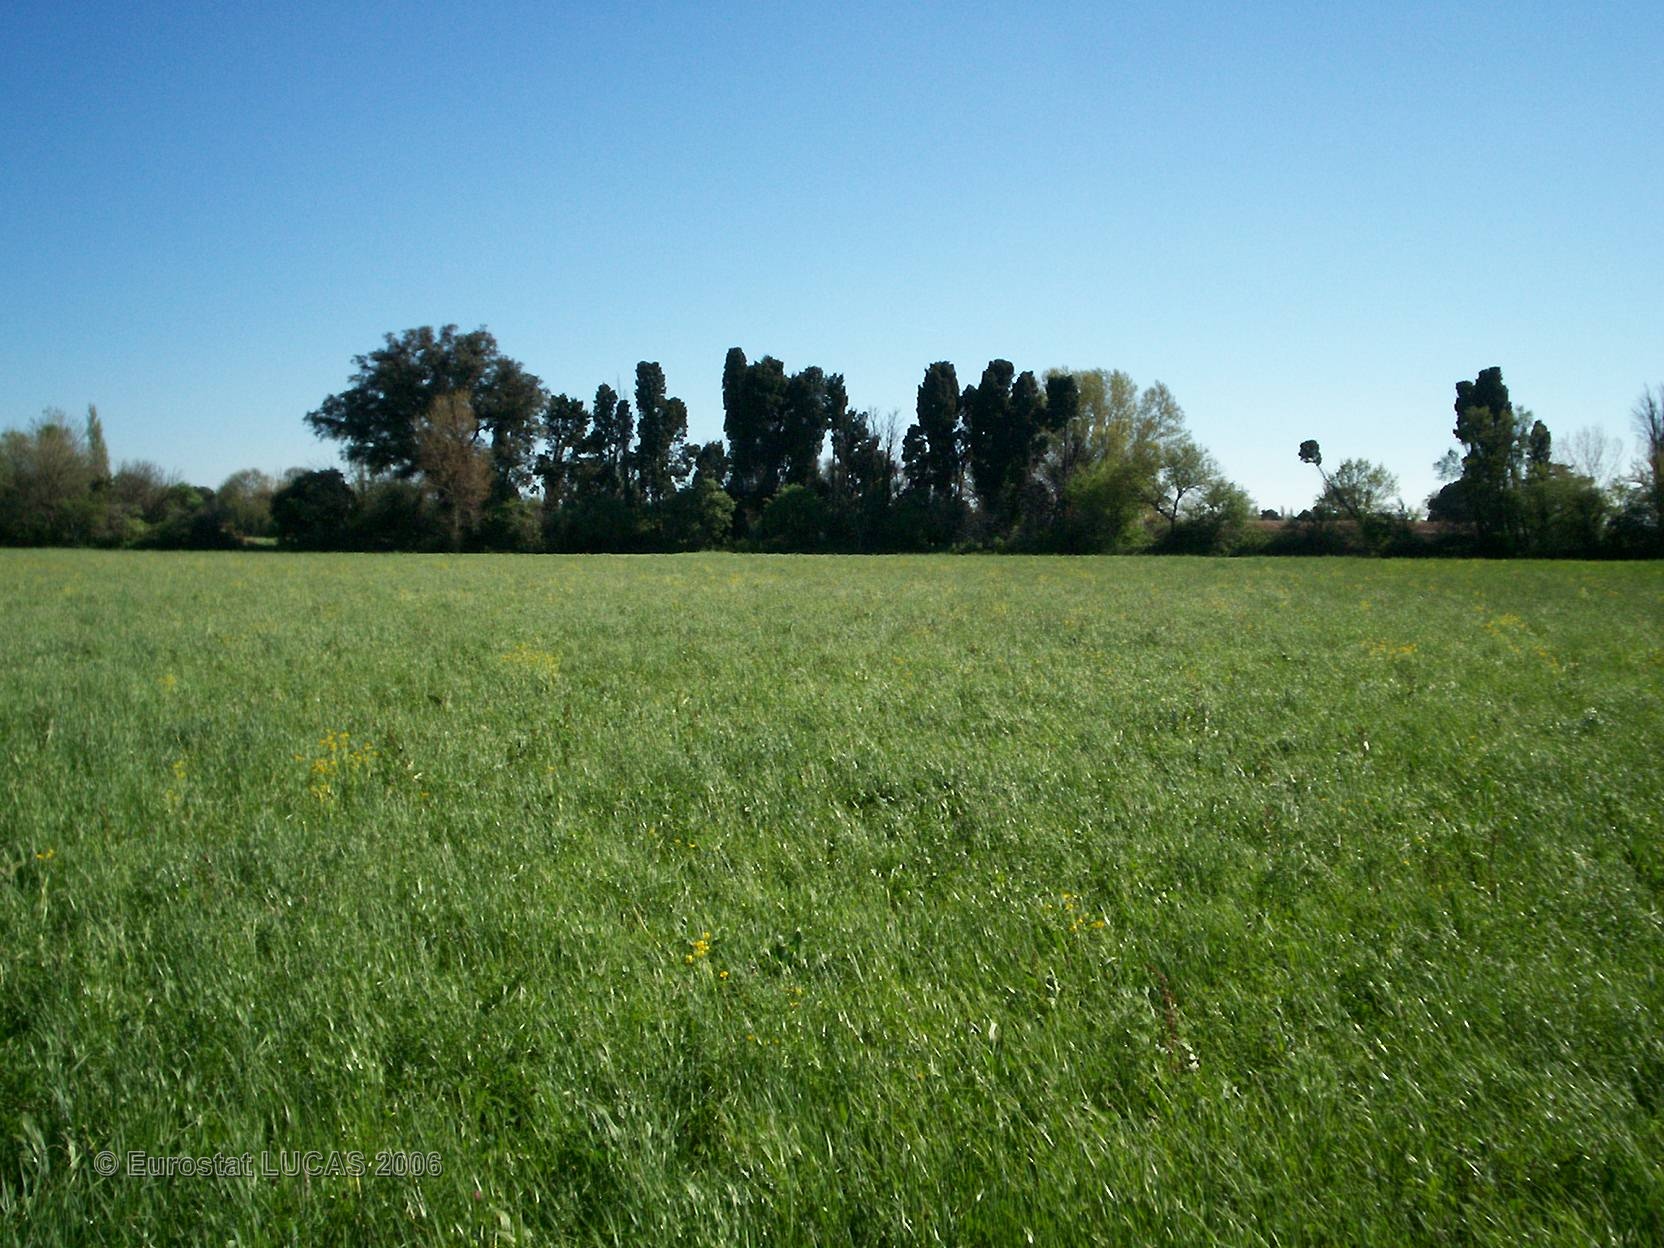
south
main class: Grassland
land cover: Grassland without tree/shrub cover
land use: Agriculture (excluding fallow land and kitchen gardens)
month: April
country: FR
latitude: 43.5600
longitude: 4.9712
